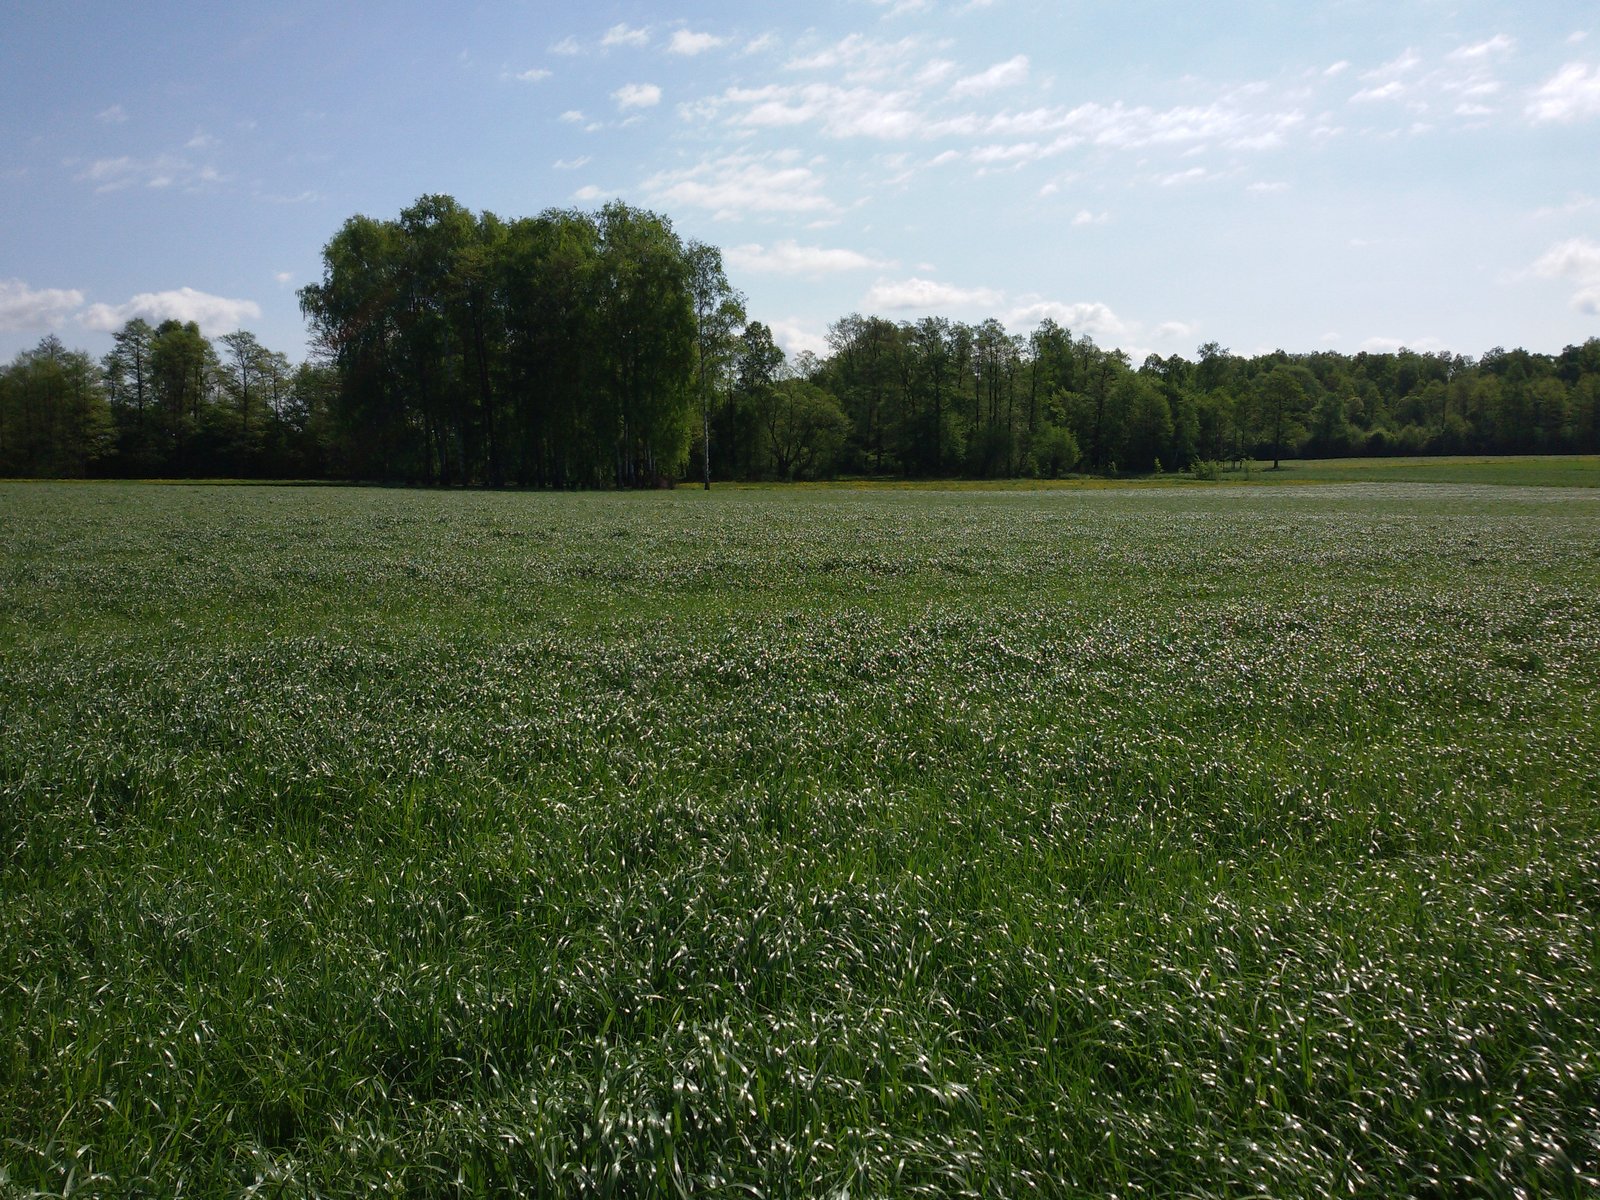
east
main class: Cropland
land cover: Temporary grasslands
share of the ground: > 75 %
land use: Agriculture (excluding fallow land and kitchen gardens)
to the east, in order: Temporary grasslands; Oats; Grassland without tree/shrub cover; Ditches and canals; Broadleaved woodland; Grassland without tree/shrub cover
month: May
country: PL
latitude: 52.9056
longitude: 22.2388
